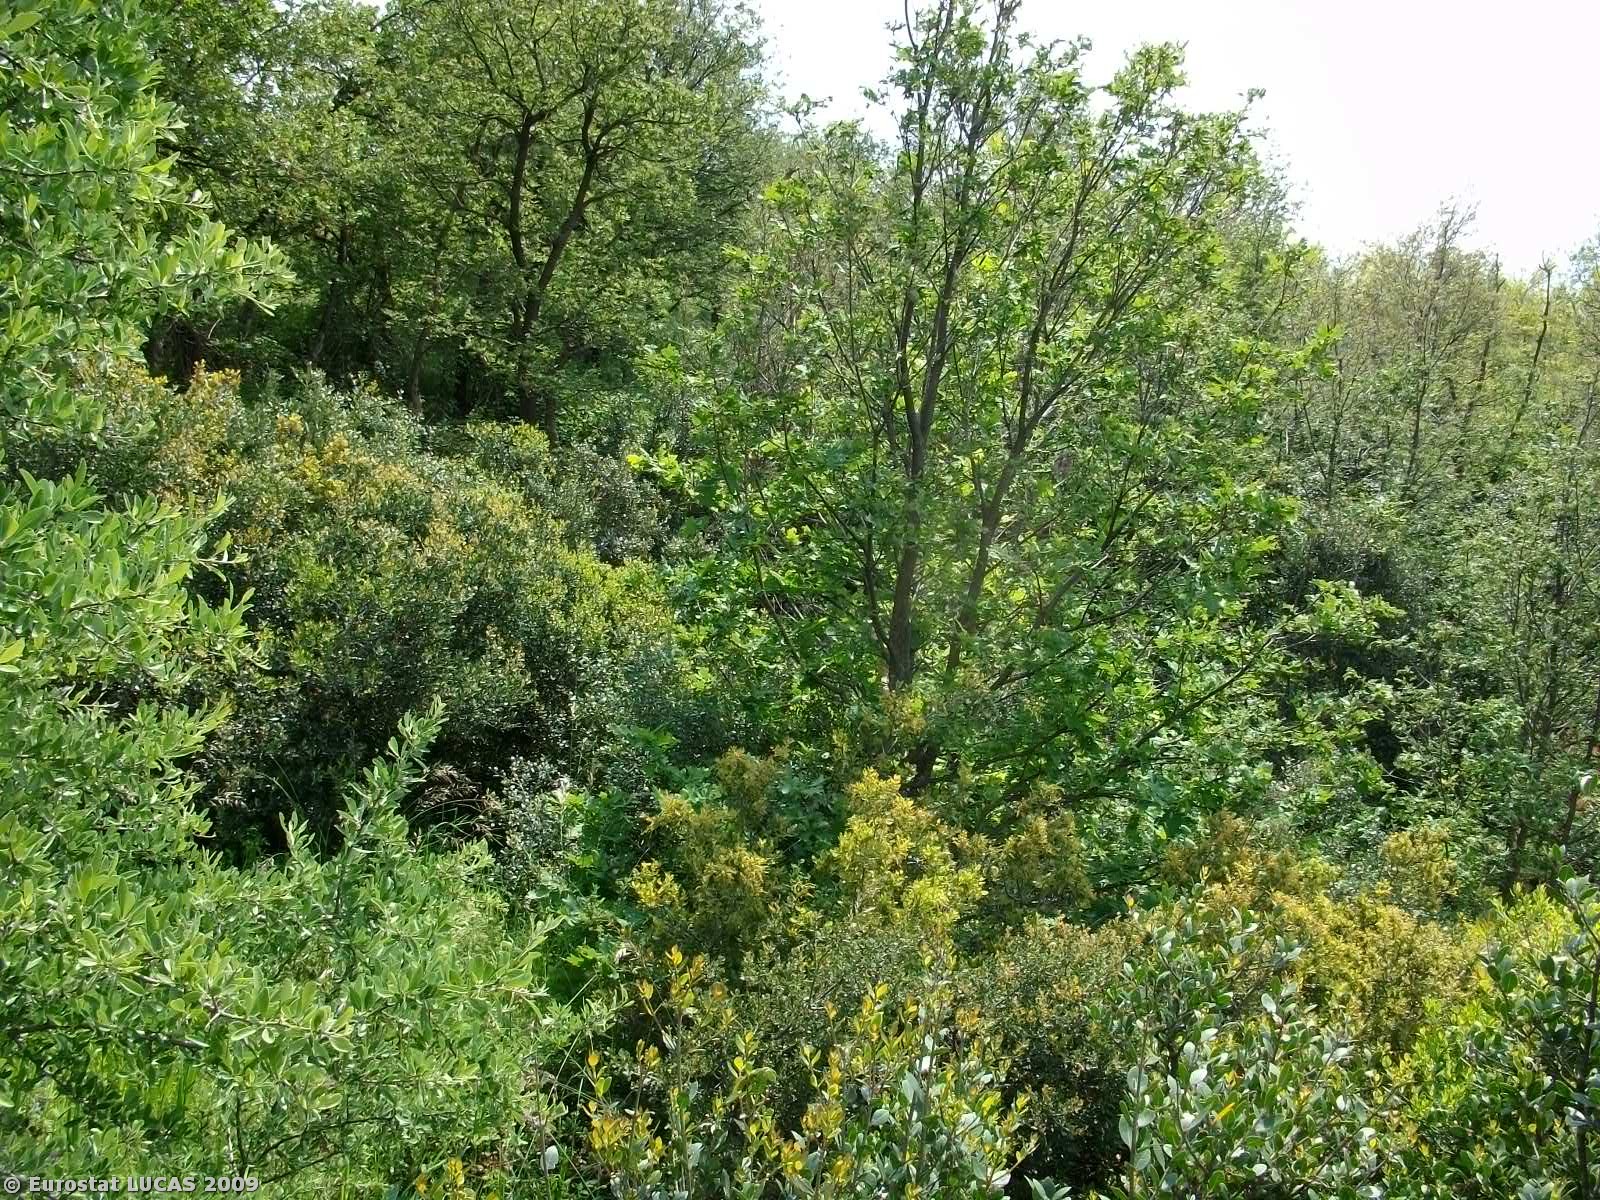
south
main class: Shrubland
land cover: Shrubland with sparse tree cover
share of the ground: > 75 %
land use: Unused
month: May
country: GR
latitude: 39.2079
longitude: 22.5039
